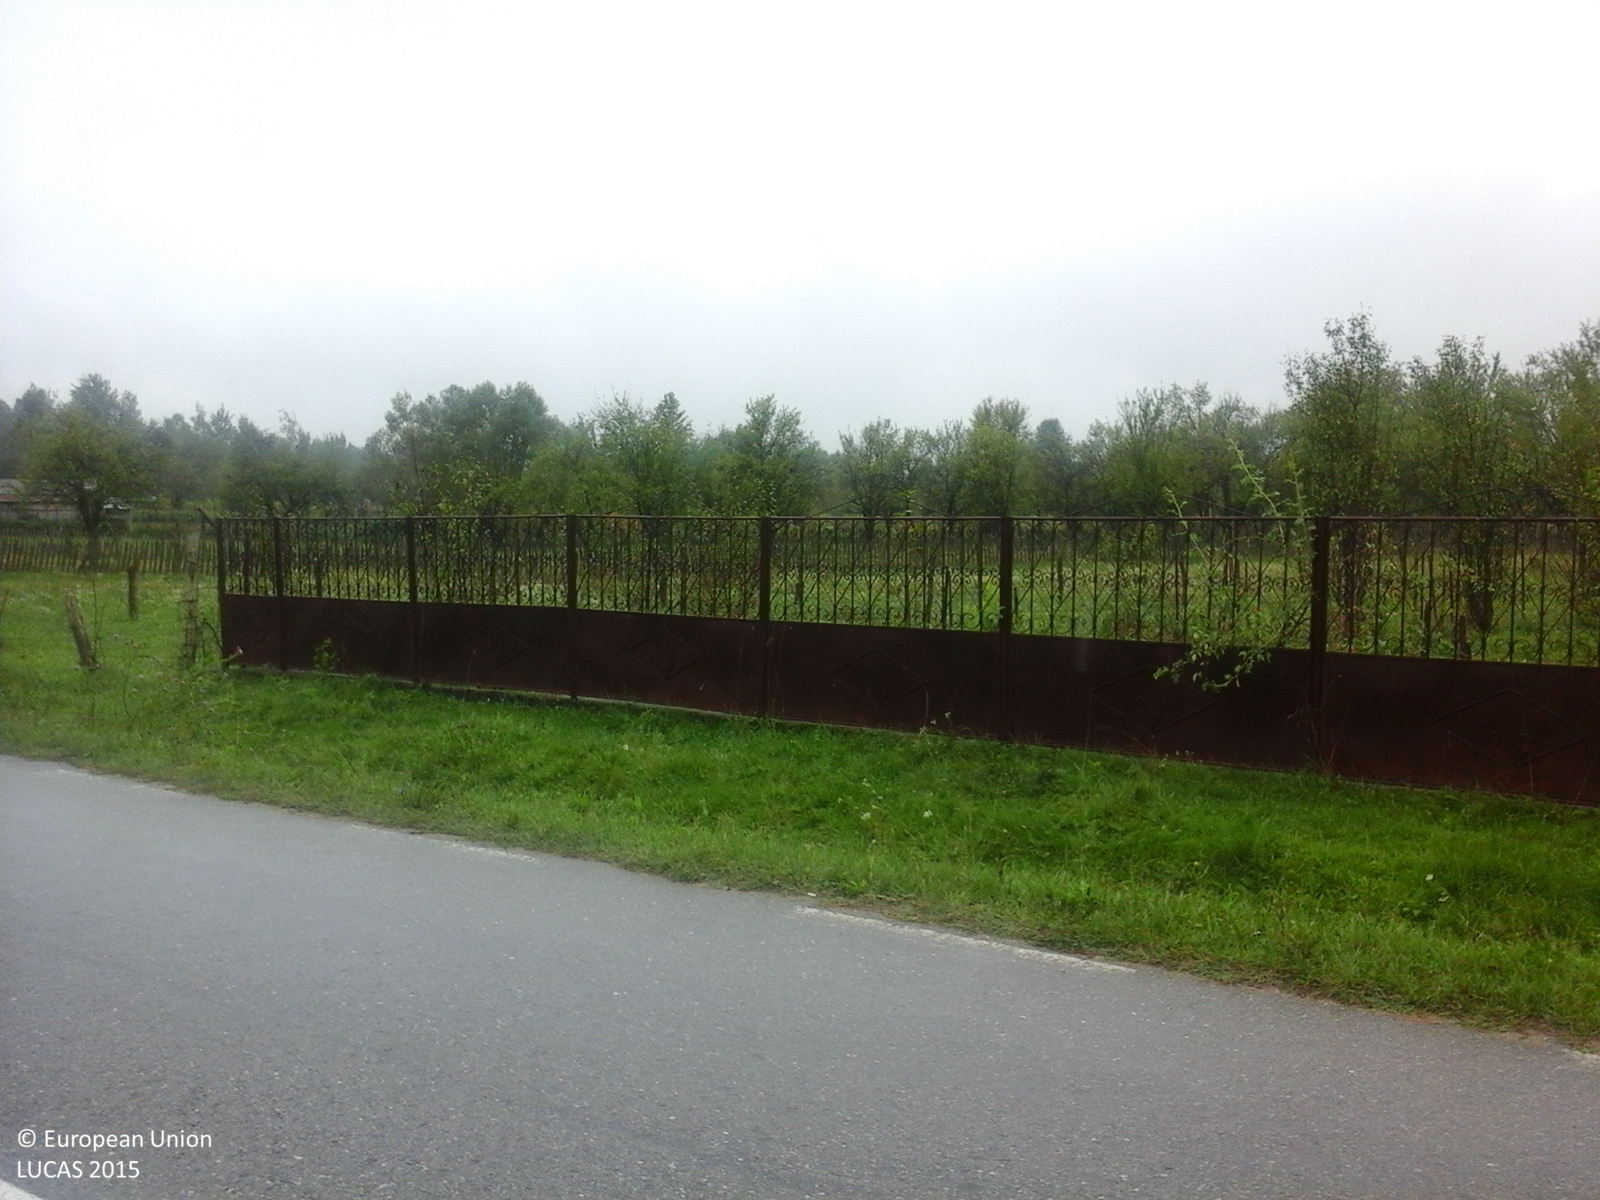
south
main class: Cropland
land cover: Vineyards
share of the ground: 10 - 25 %
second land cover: Grassland without tree/shrub cover
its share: > 75 %
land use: Kitchen garden
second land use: Residential
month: September
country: RO
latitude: 45.1660
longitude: 23.6101
